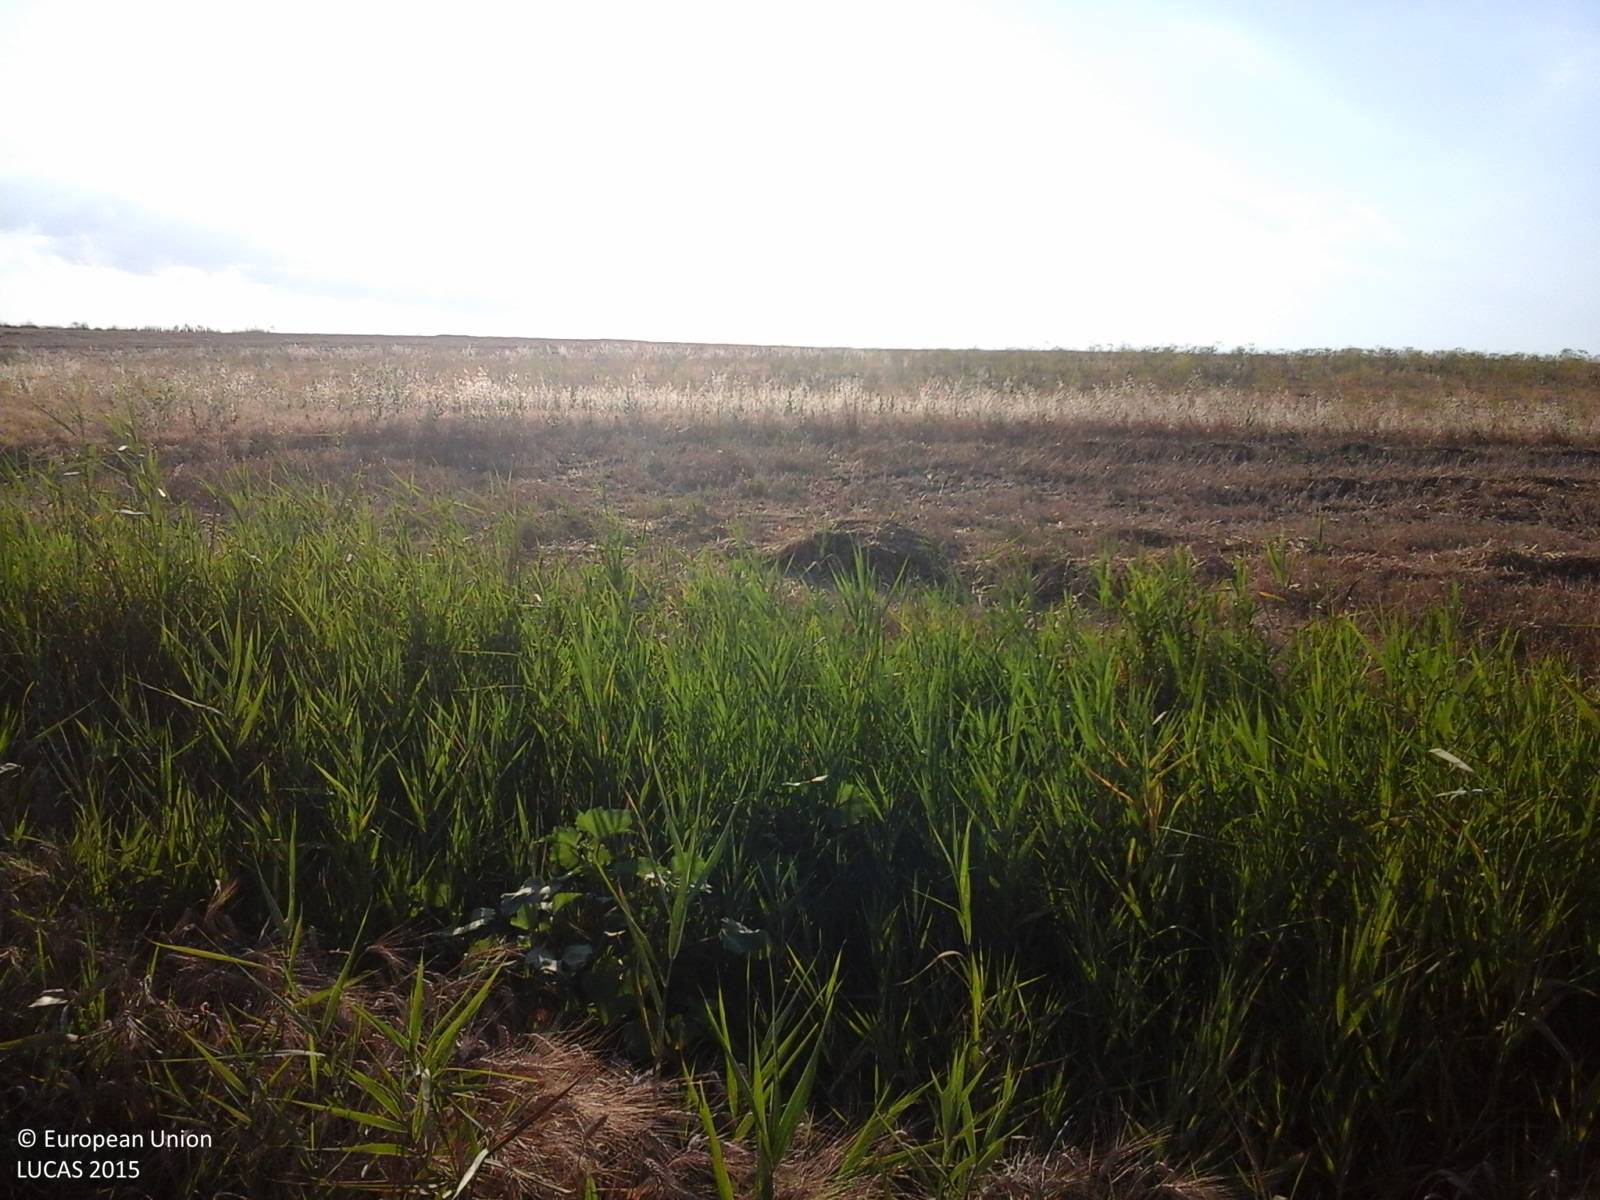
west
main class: Cropland
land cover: Dry pulses
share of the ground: > 75 %
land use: Agriculture (excluding fallow land and kitchen gardens)
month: July
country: IT
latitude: 37.8277
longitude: 12.9888
